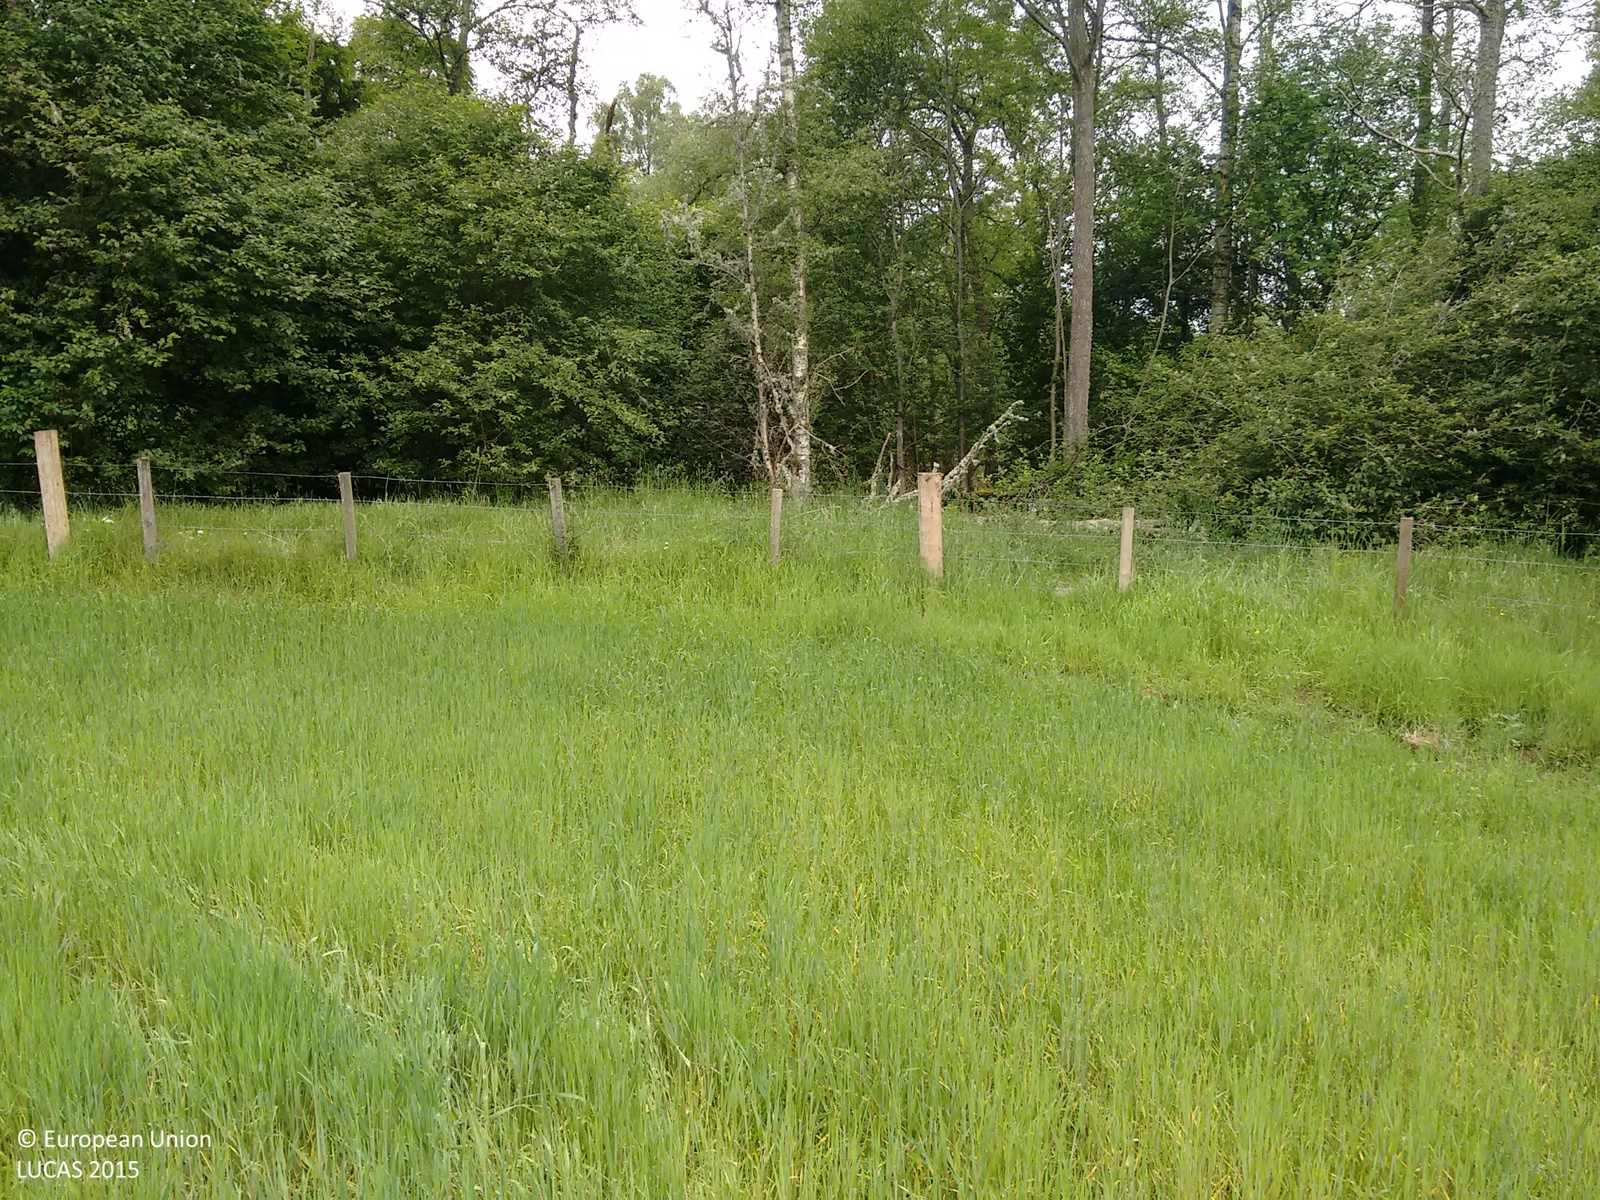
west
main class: Cropland
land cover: Barley
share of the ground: > 75 %
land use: Agriculture (excluding fallow land and kitchen gardens)
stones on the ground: < 10 %
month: June
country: GB
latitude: 57.0515
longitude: -2.6690
